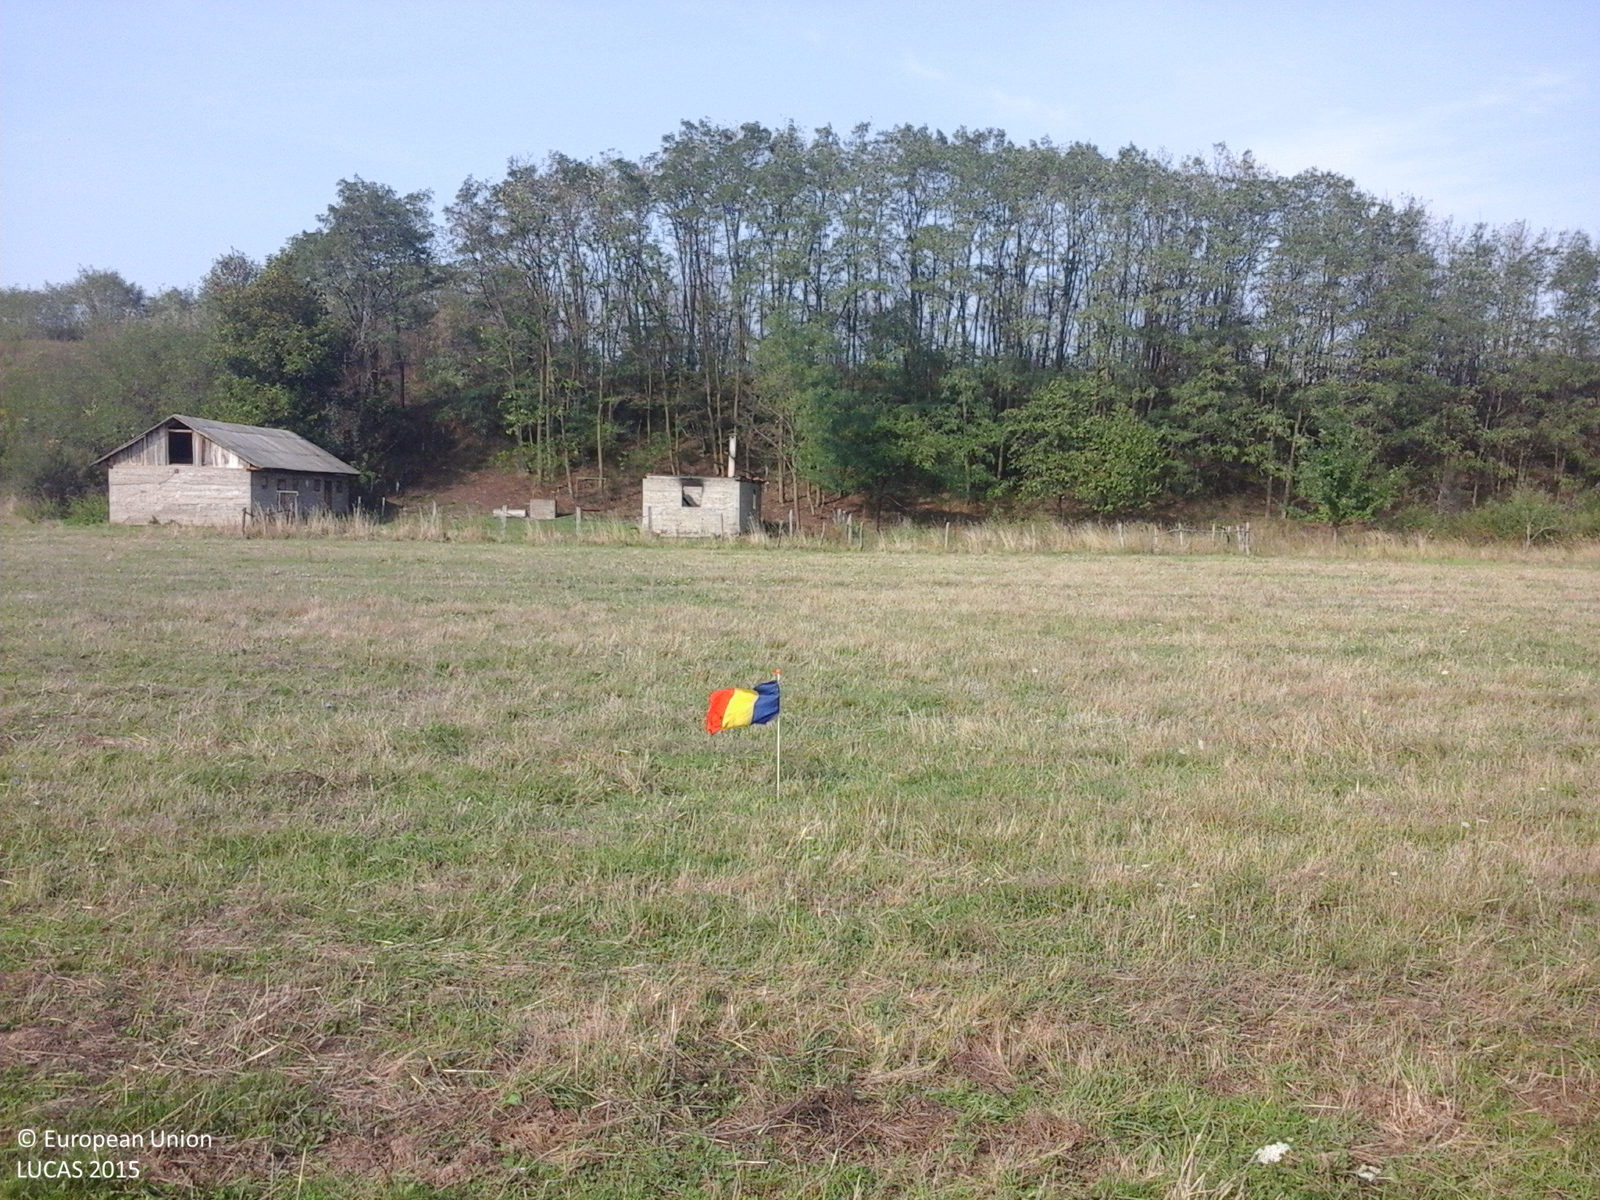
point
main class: Grassland
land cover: Grassland without tree/shrub cover
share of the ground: > 75 %
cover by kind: herbaceous plants 100 %
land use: Agriculture (excluding fallow land and kitchen gardens)
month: September
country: RO
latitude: 45.4850
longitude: 22.2085
